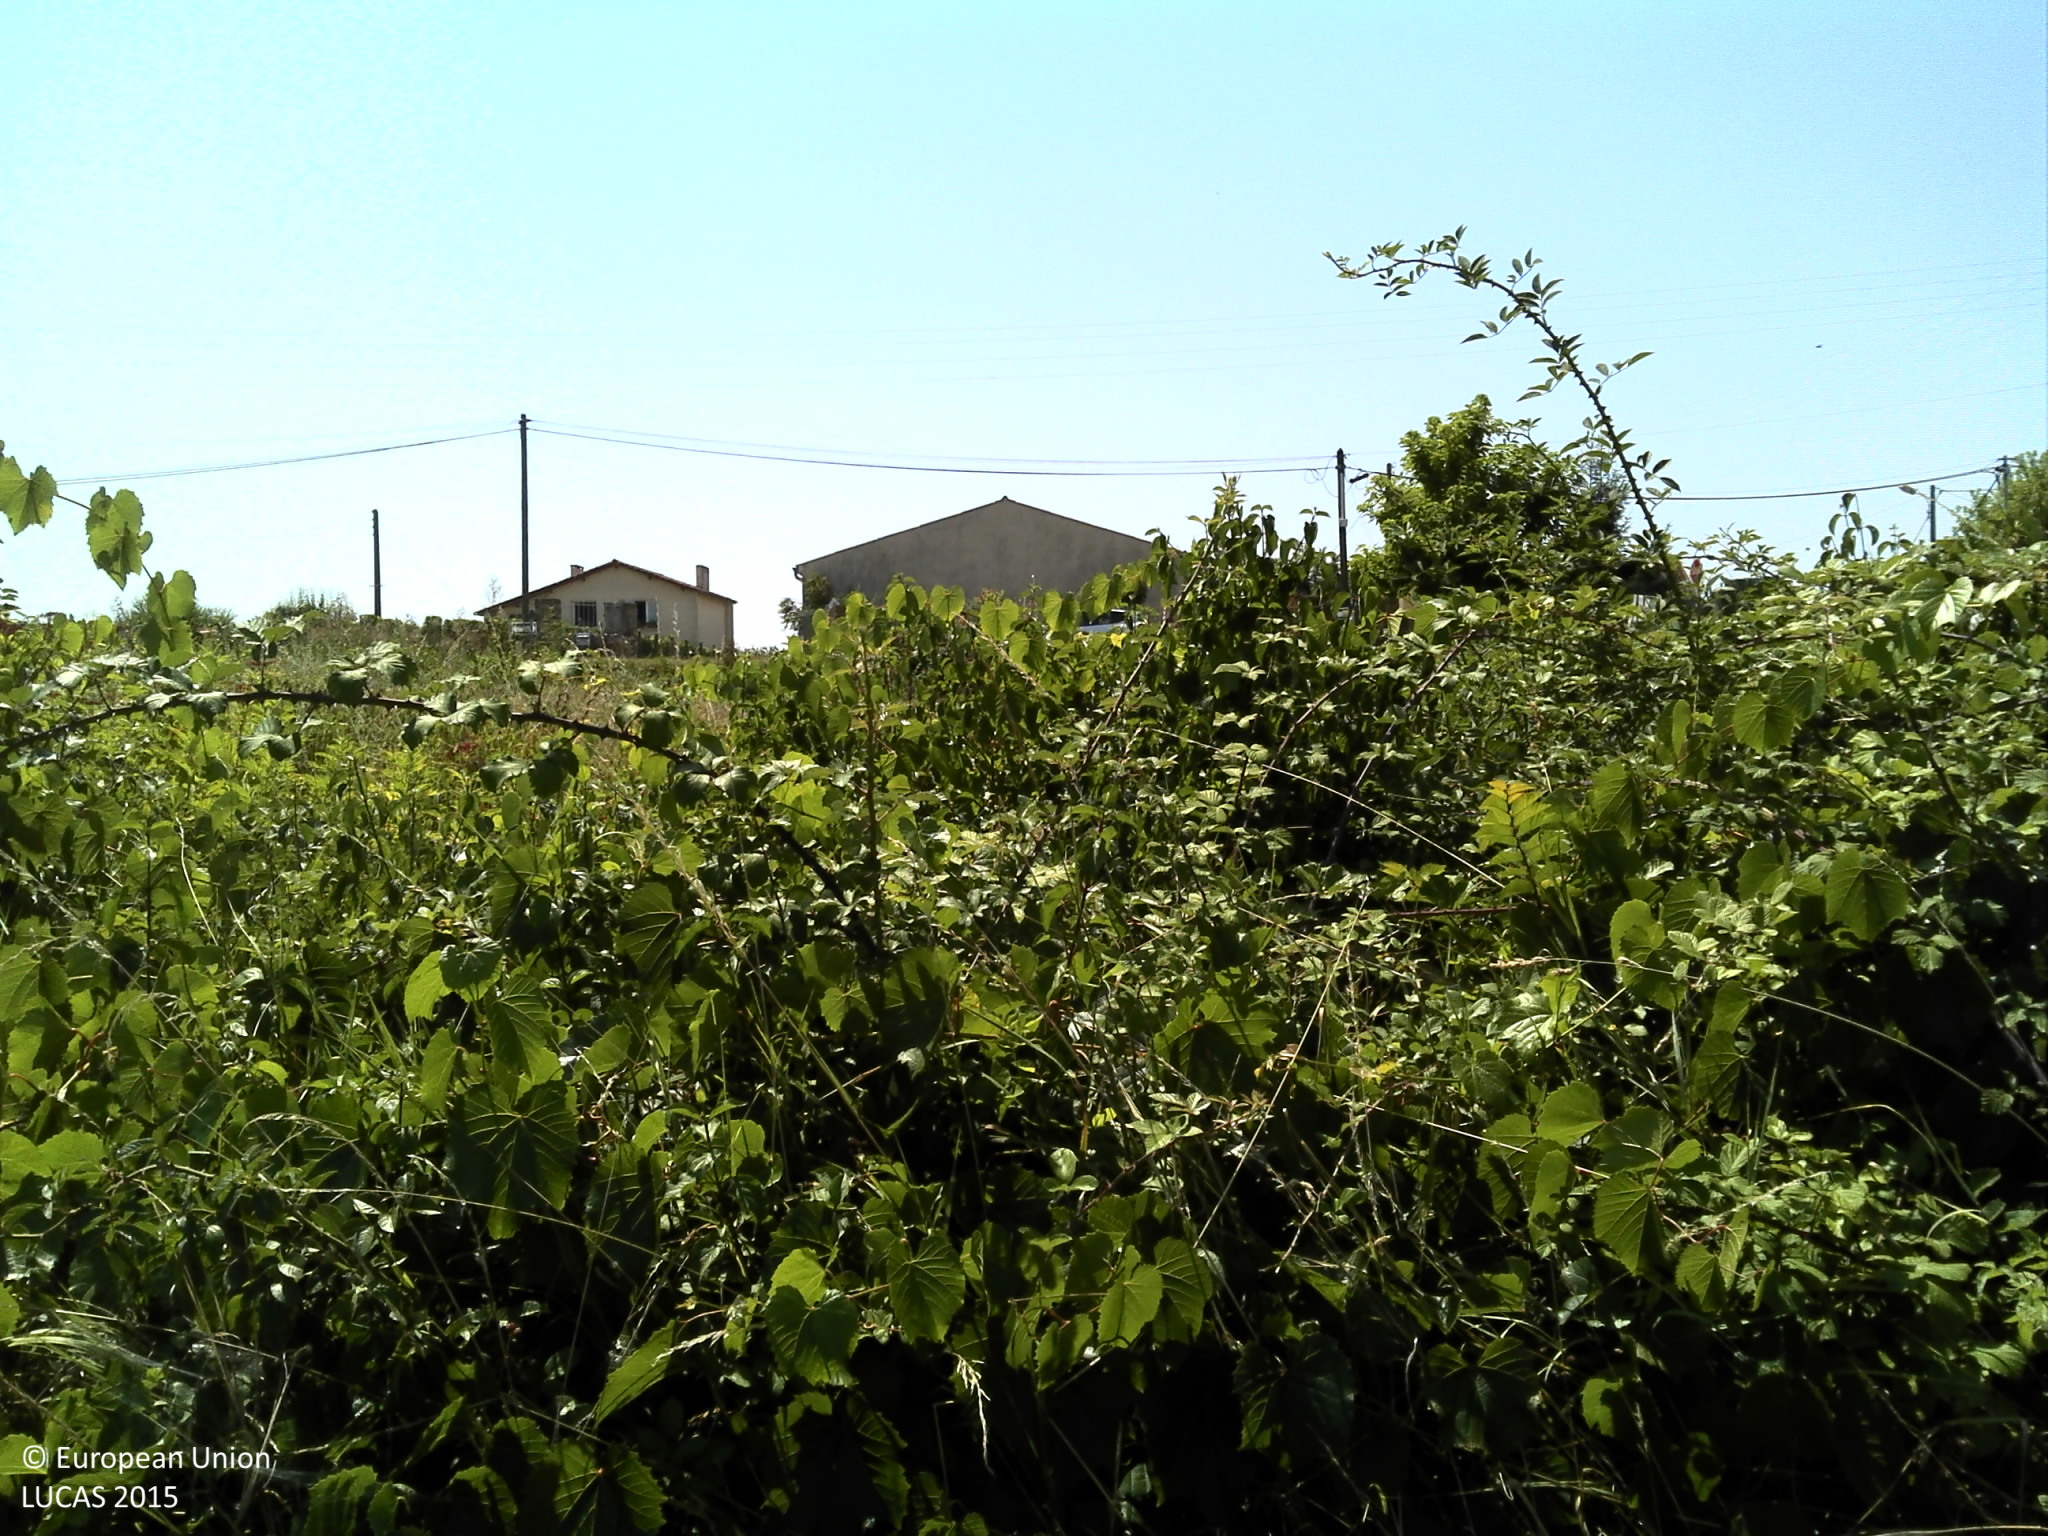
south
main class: Shrubland
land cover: Shrubland without tree cover
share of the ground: > 75 %
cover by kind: shrubs 100 %
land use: Semi-natural and natural areas not in use
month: August
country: FR
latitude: 45.0348
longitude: -0.4910
